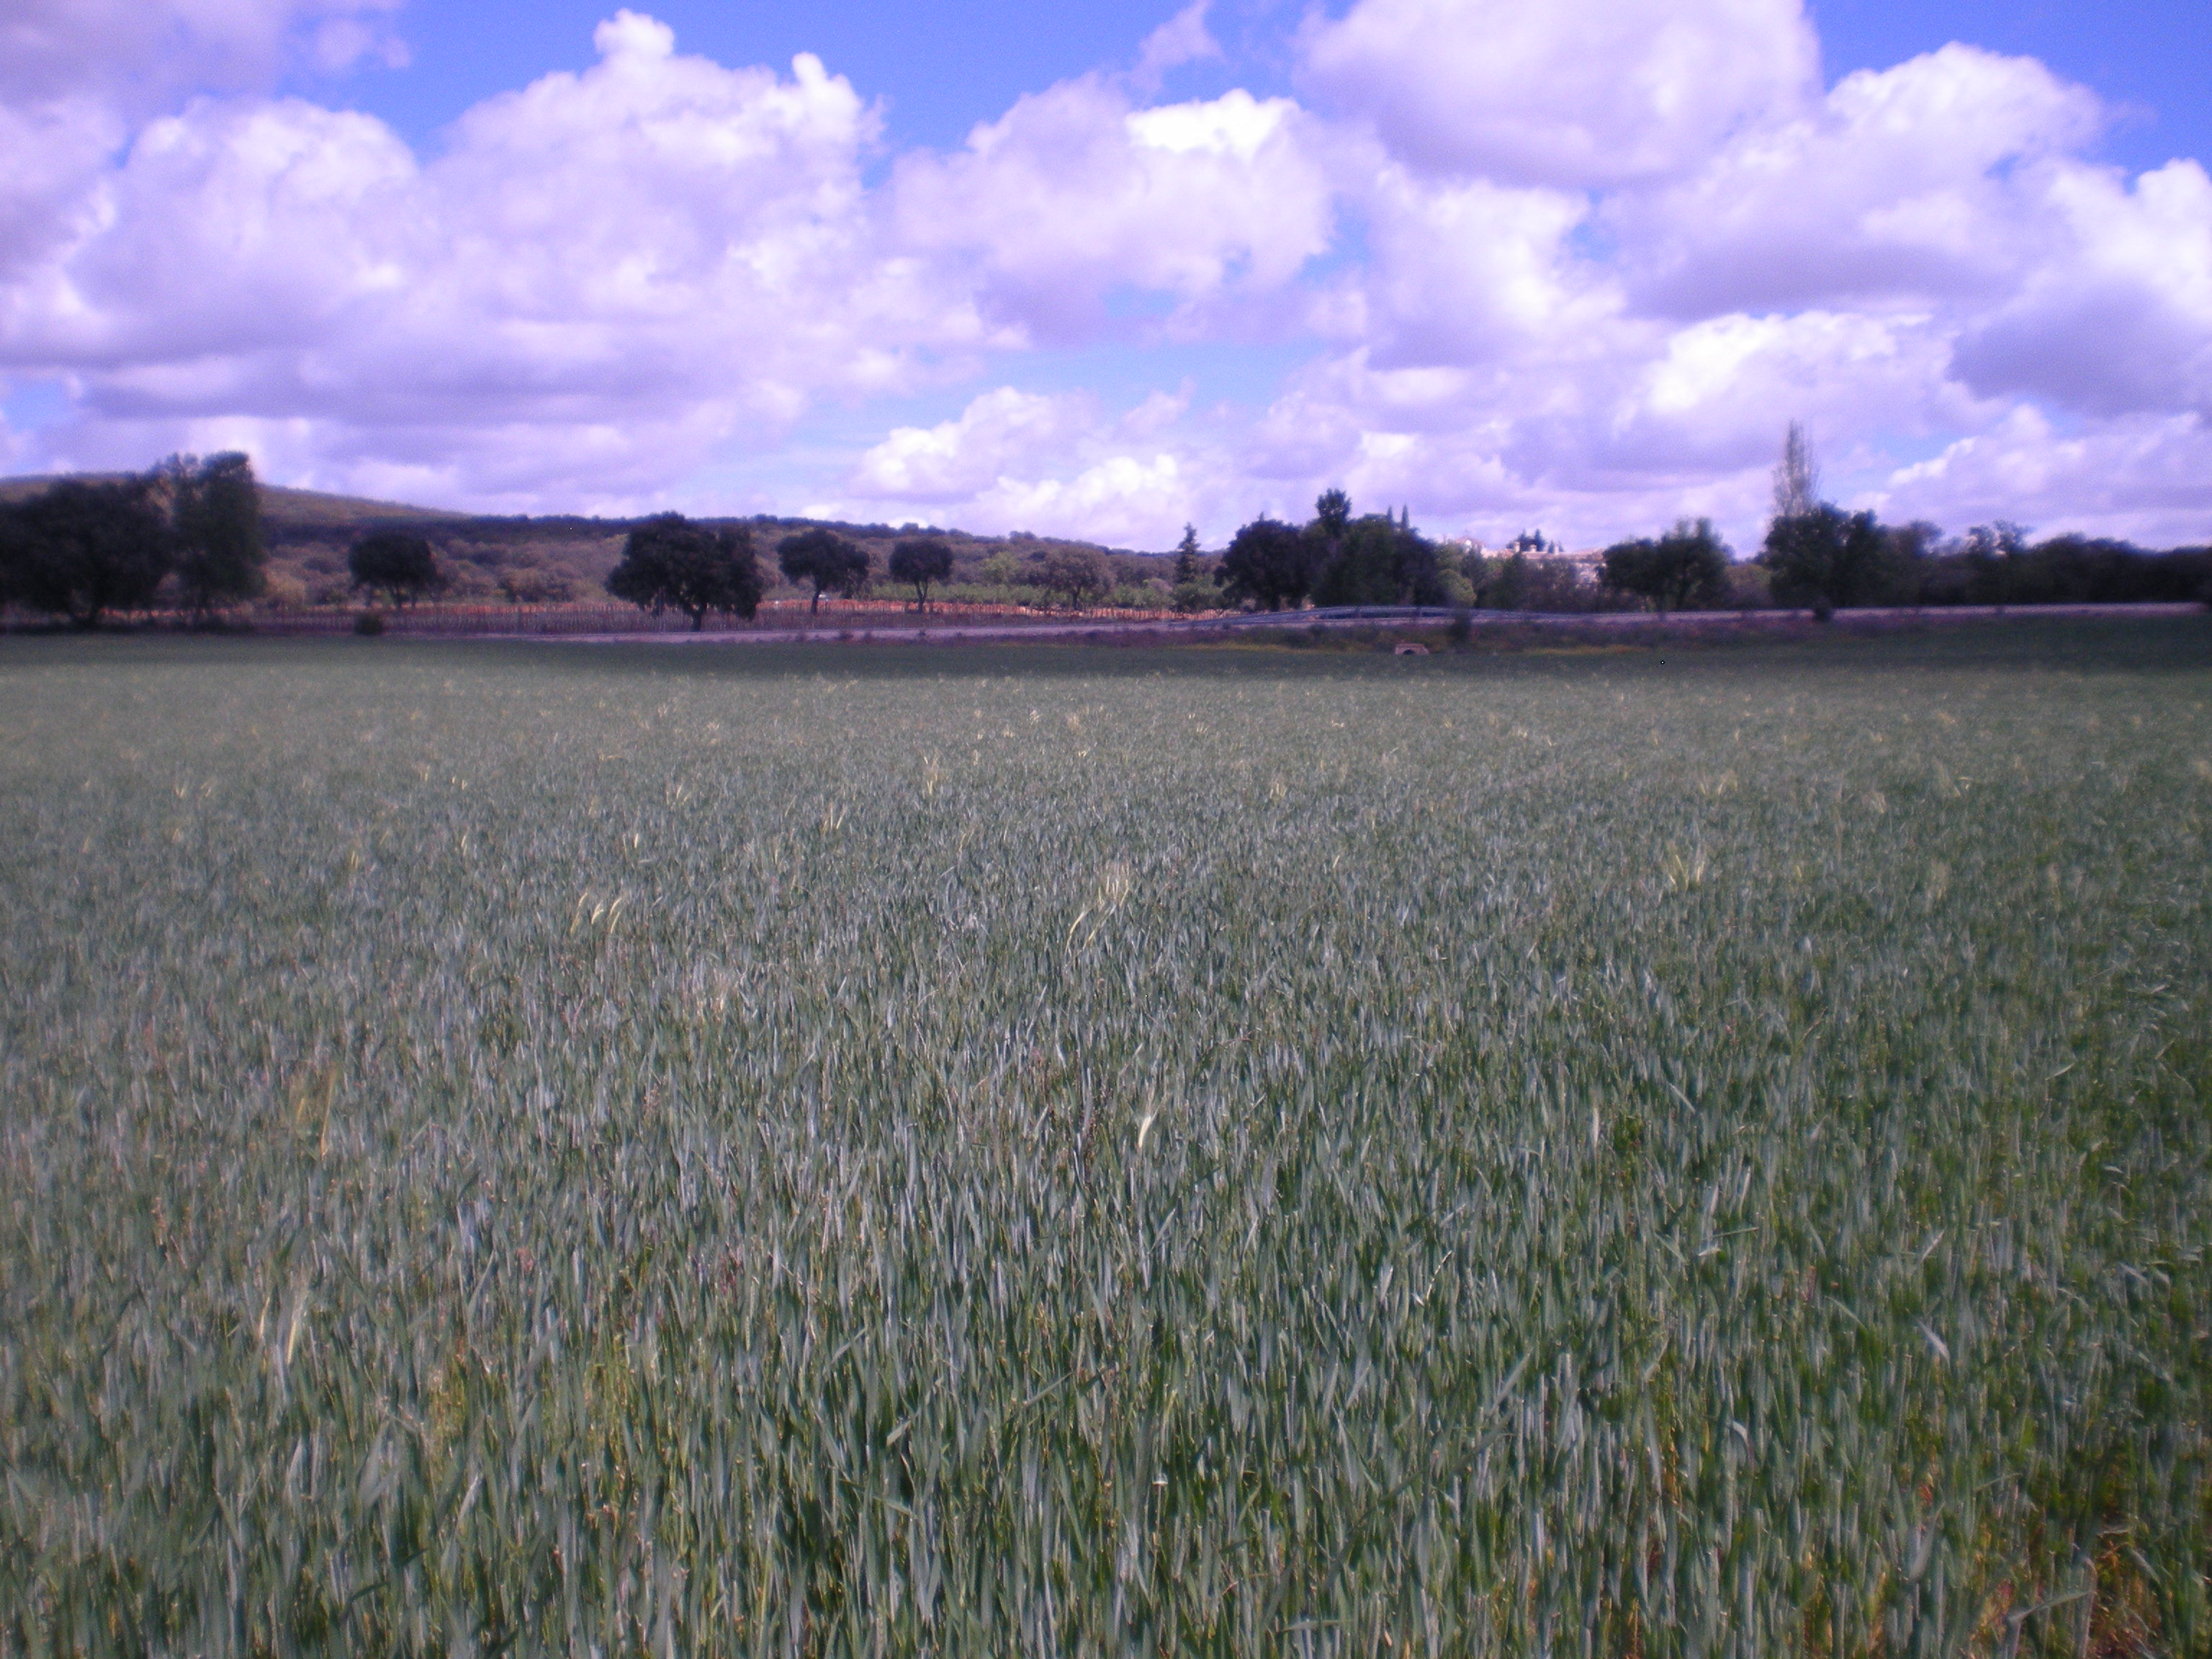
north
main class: Cropland
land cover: Durum wheat
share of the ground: > 75 %
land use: Agriculture (excluding fallow land and kitchen gardens)
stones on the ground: 10 - 25 %
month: April
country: ES
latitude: 38.5483
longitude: -3.1896
